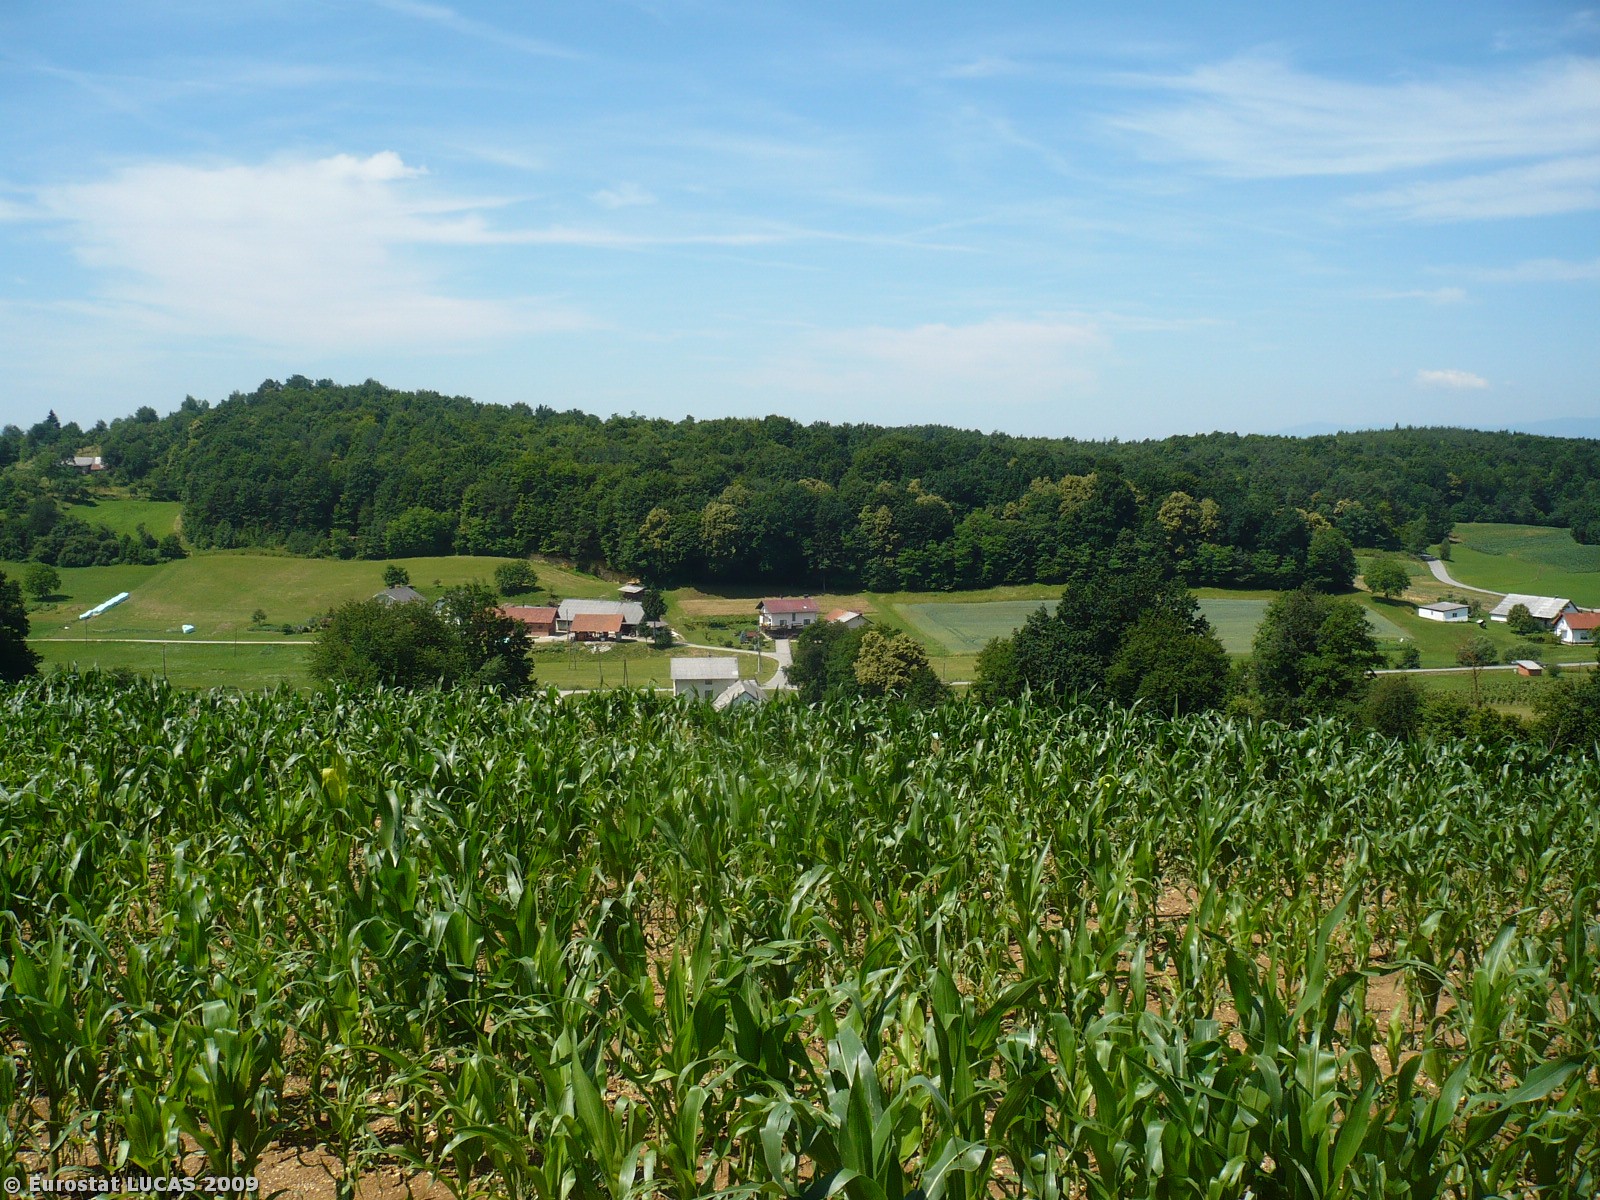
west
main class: Cropland
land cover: Maize
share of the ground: > 75 %
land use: Agriculture (excluding fallow land and kitchen gardens)
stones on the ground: < 10 %
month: June
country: SI
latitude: 46.4521
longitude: 16.0274
